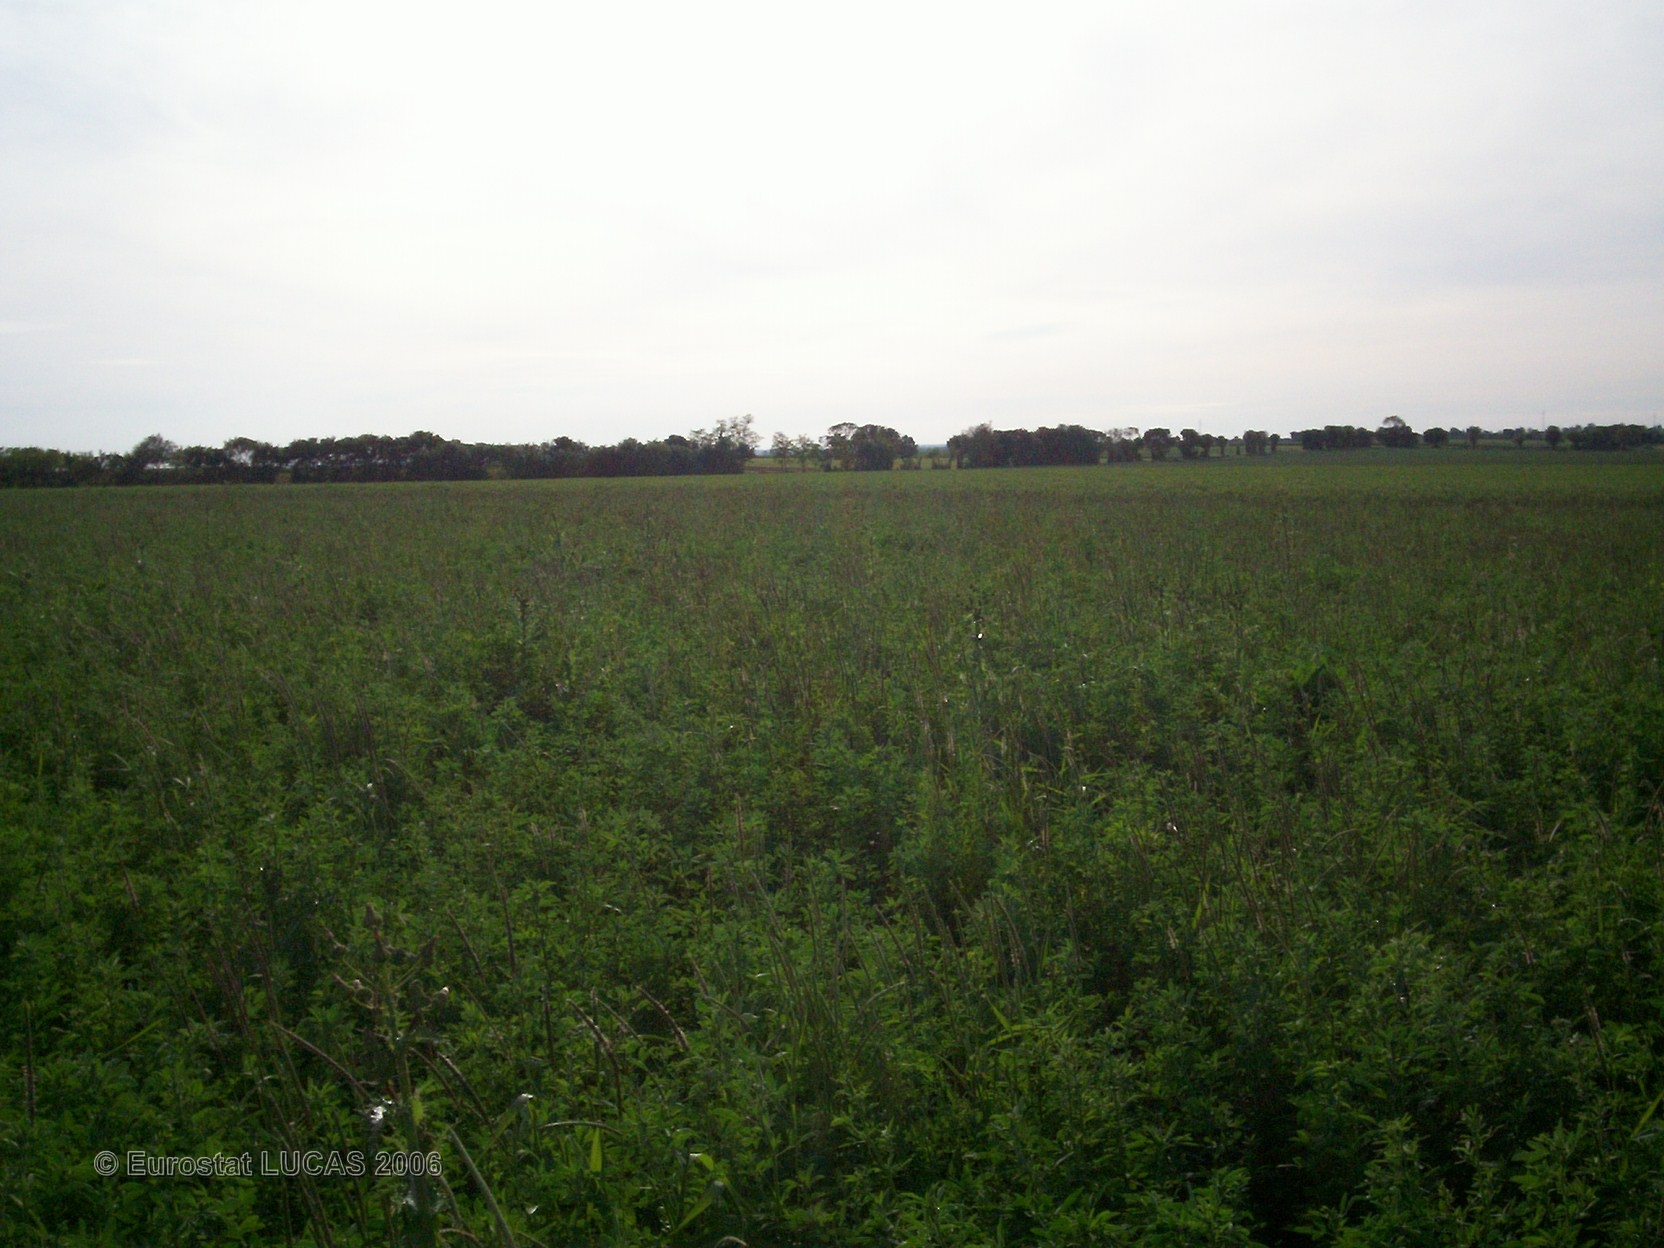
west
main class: Cropland
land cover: Lucerne
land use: Agriculture (excluding fallow land and kitchen gardens)
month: May
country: FR
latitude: 46.1540
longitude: -0.1863
